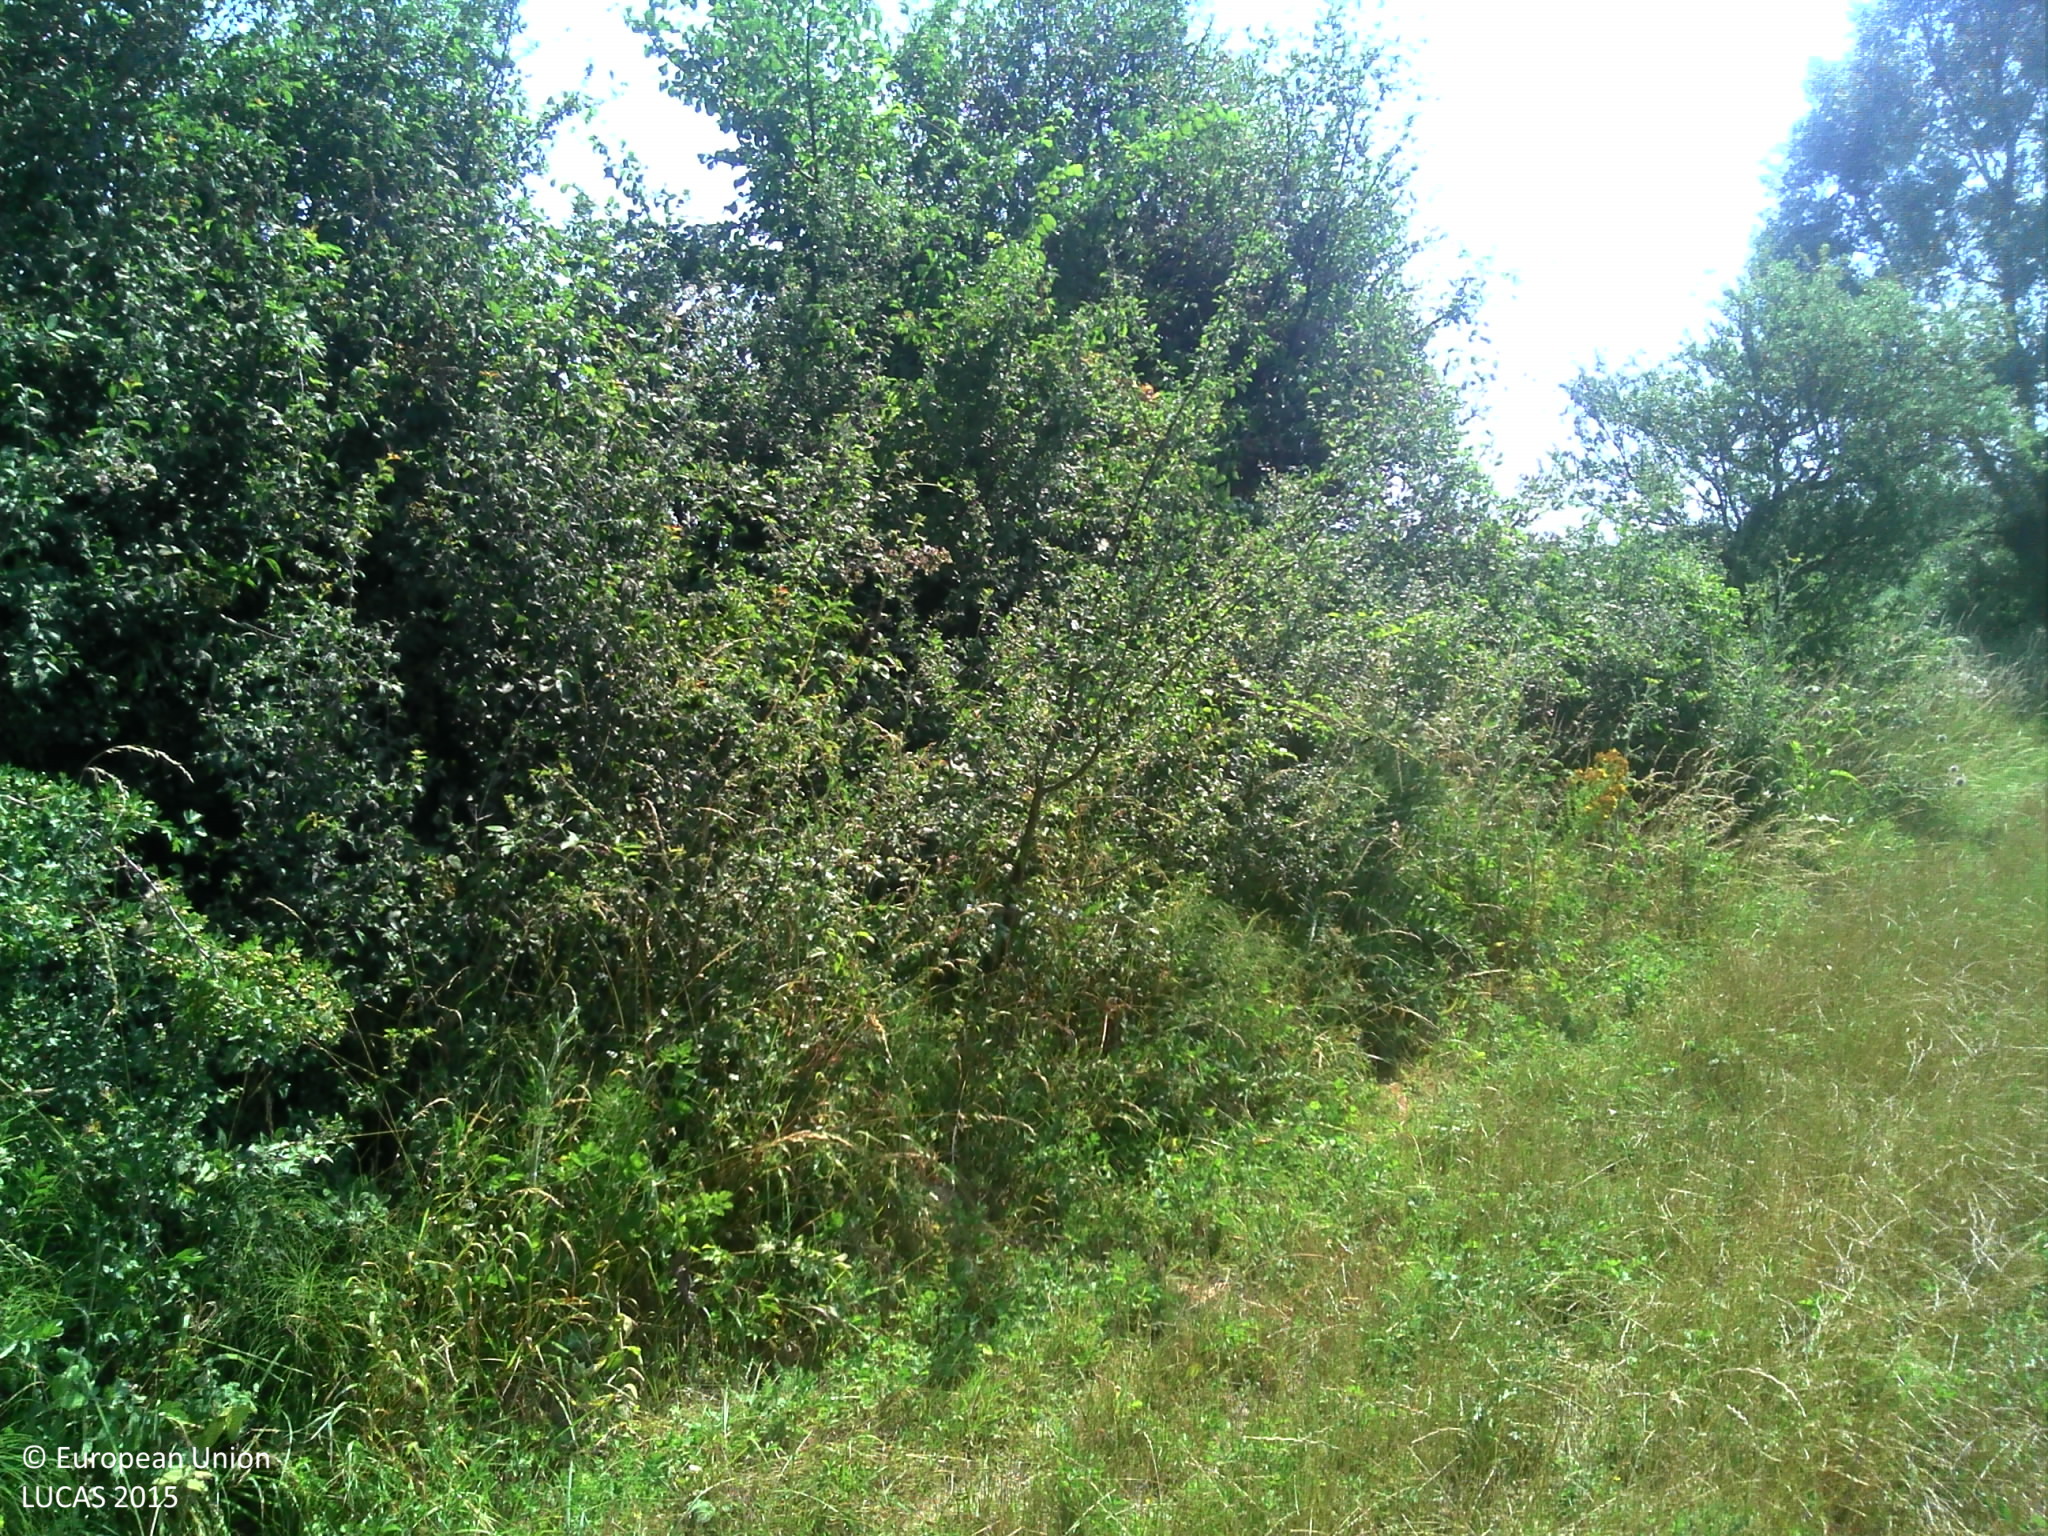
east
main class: Grassland
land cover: Grassland without tree/shrub cover
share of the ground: > 75 %
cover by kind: herbaceous plants 100 %
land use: Agriculture (excluding fallow land and kitchen gardens)
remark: Harvested field
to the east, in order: Grassland without tree/shrub cover; Abandoned hedges; Common wheat; Grass margins; Ditches and canals; Grass margins; Paved roads, cycling and walking lanes; Grass margins; Ditches and canals; Grass margins; Grassland without tree/shrub cover
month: July
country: FR
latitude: 43.3471
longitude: 1.0583
